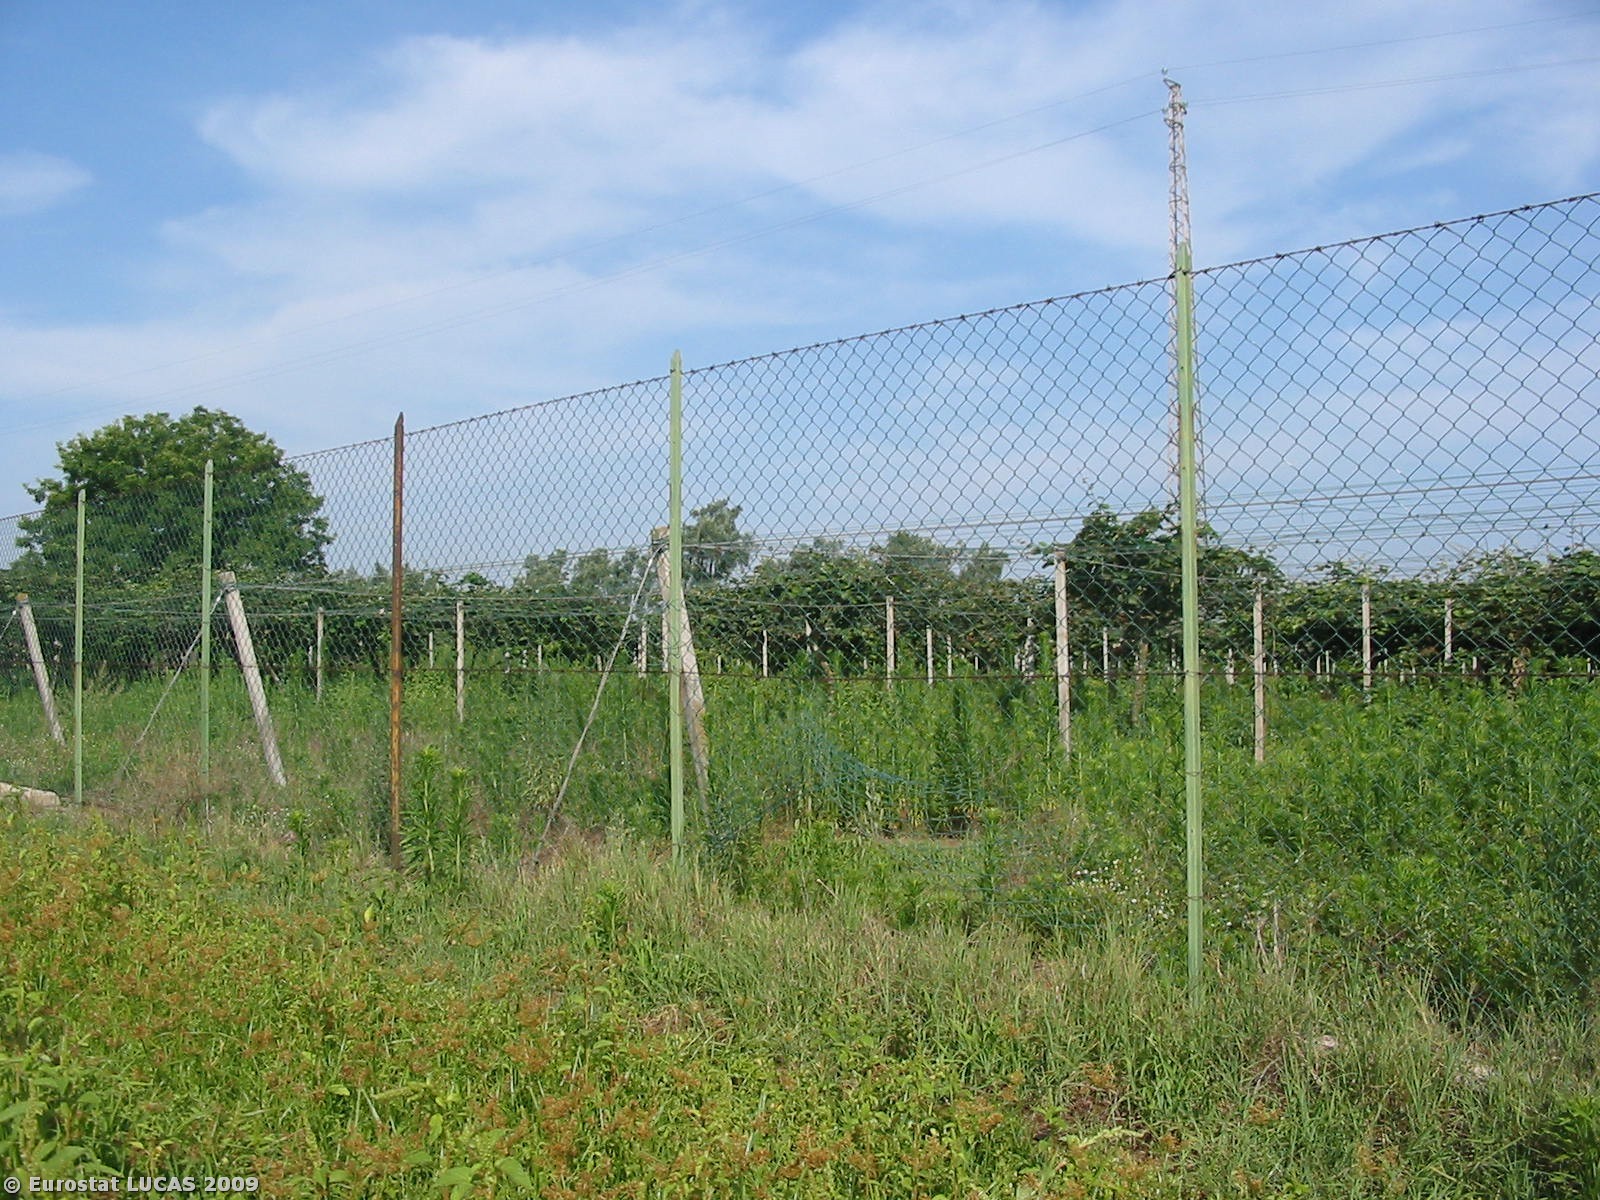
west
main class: Cropland
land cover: Other citrus fruit
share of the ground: 50 - 75 %
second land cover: Spontaneously vegetated surfaces
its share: > 75 %
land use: Agriculture (excluding fallow land and kitchen gardens)
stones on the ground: < 10 %
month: July
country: IT
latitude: 38.4517
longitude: 15.9580
